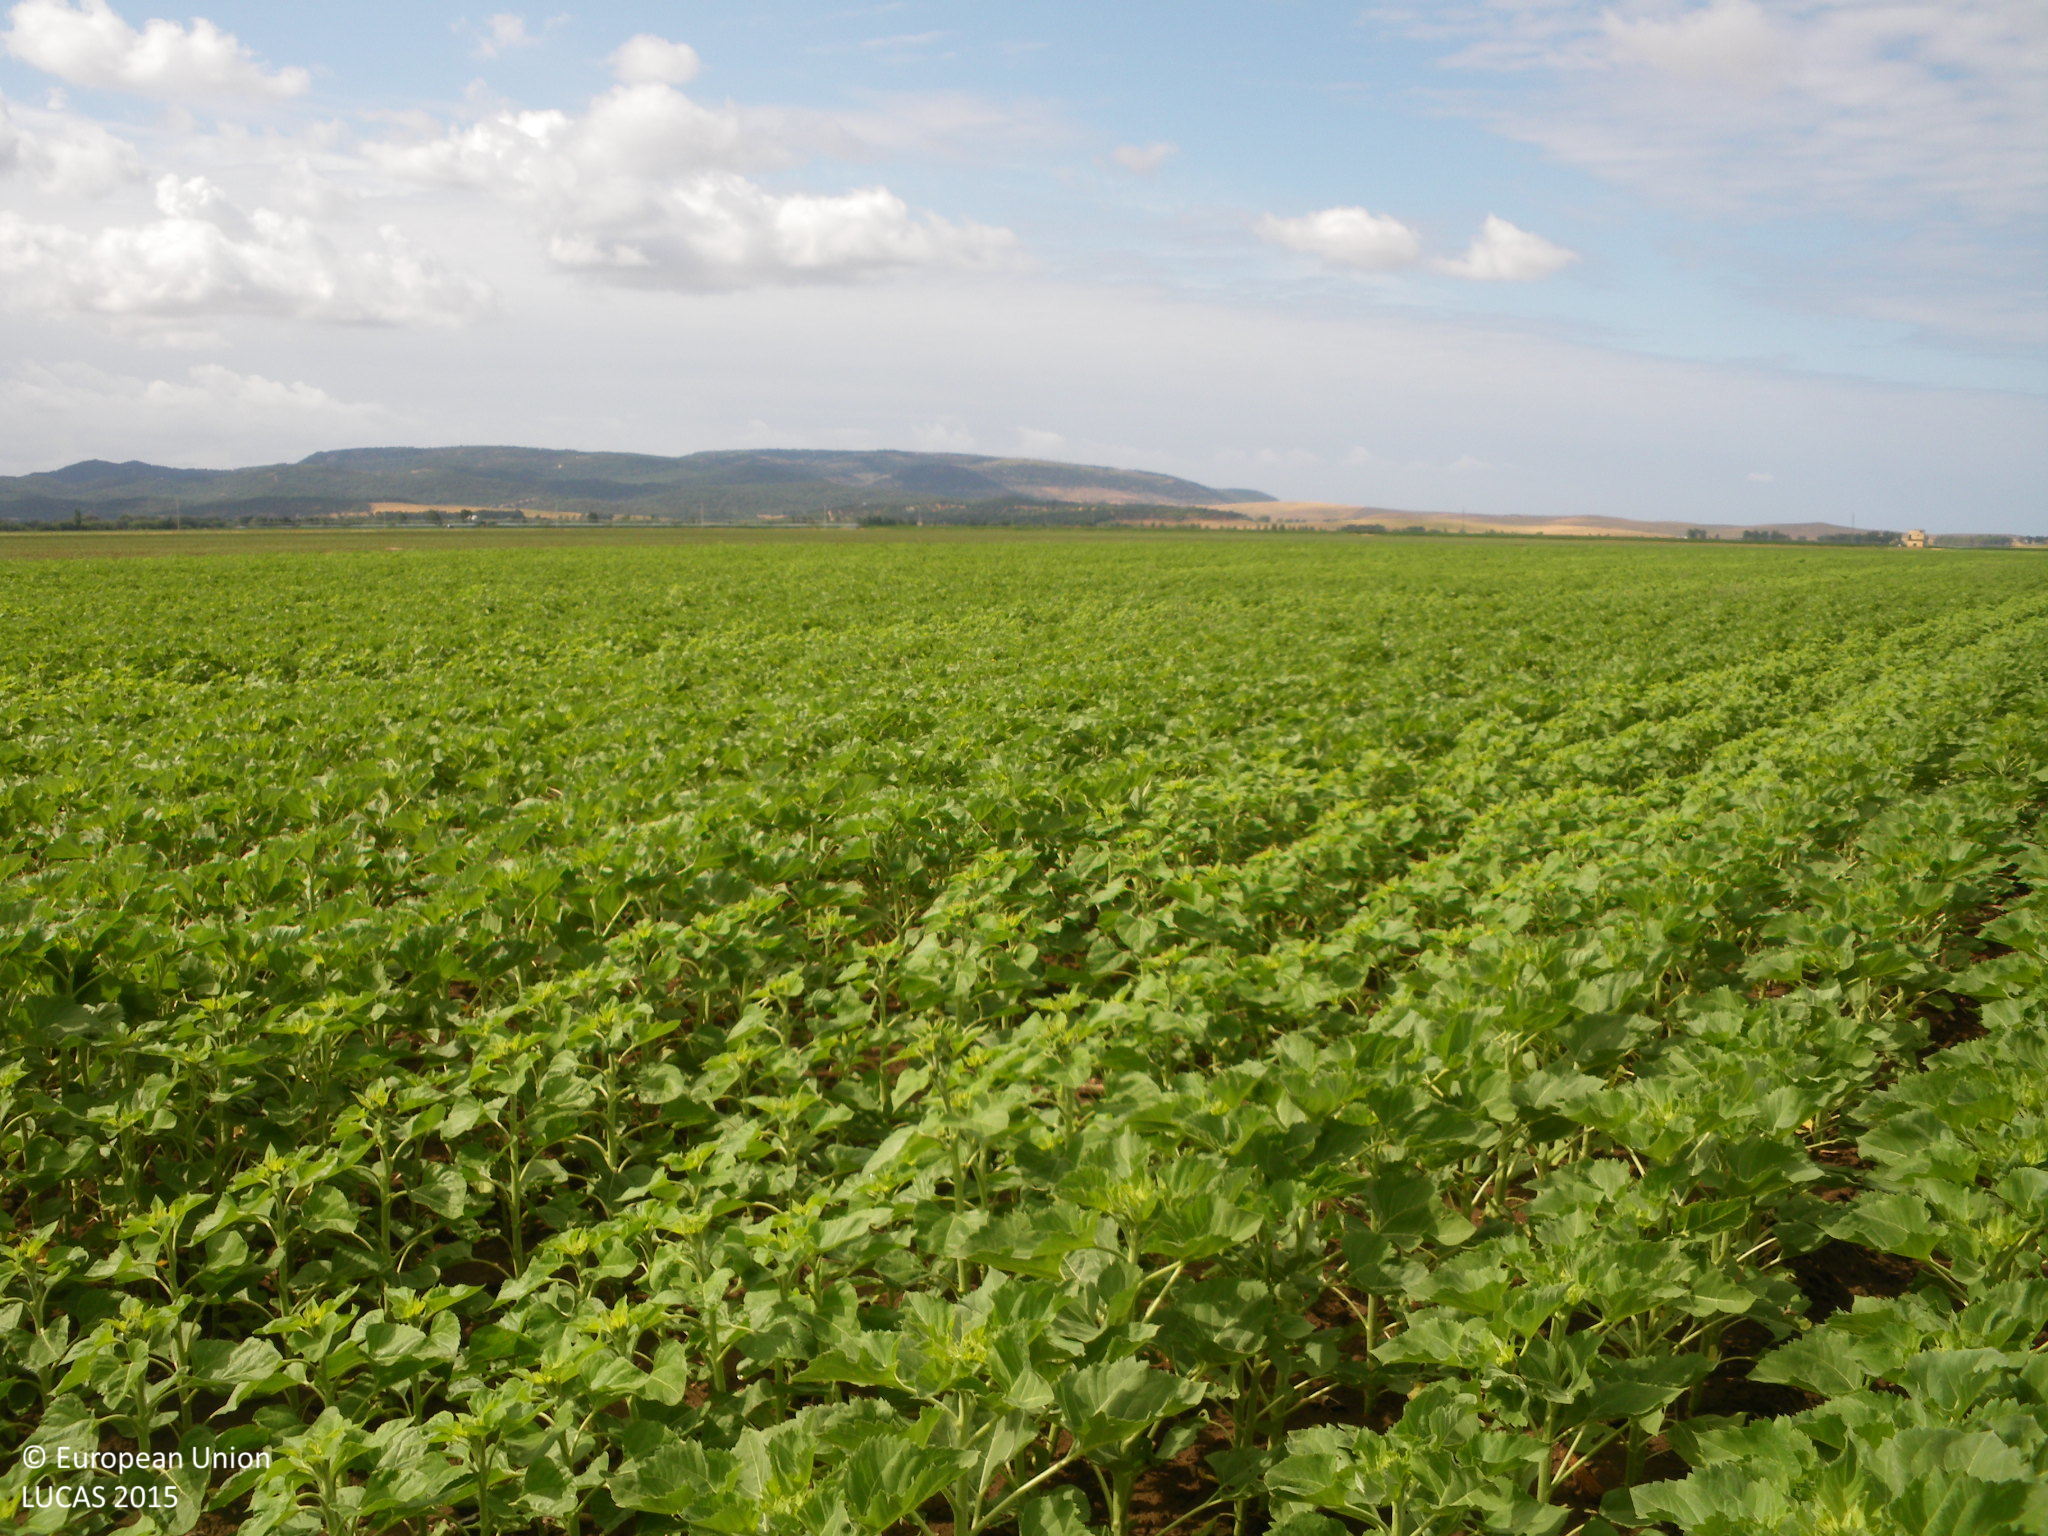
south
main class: Cropland
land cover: Sunflower
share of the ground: > 75 %
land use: Agriculture (excluding fallow land and kitchen gardens)
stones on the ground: < 10 %
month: June
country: ES
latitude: 36.2636
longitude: -5.8380
